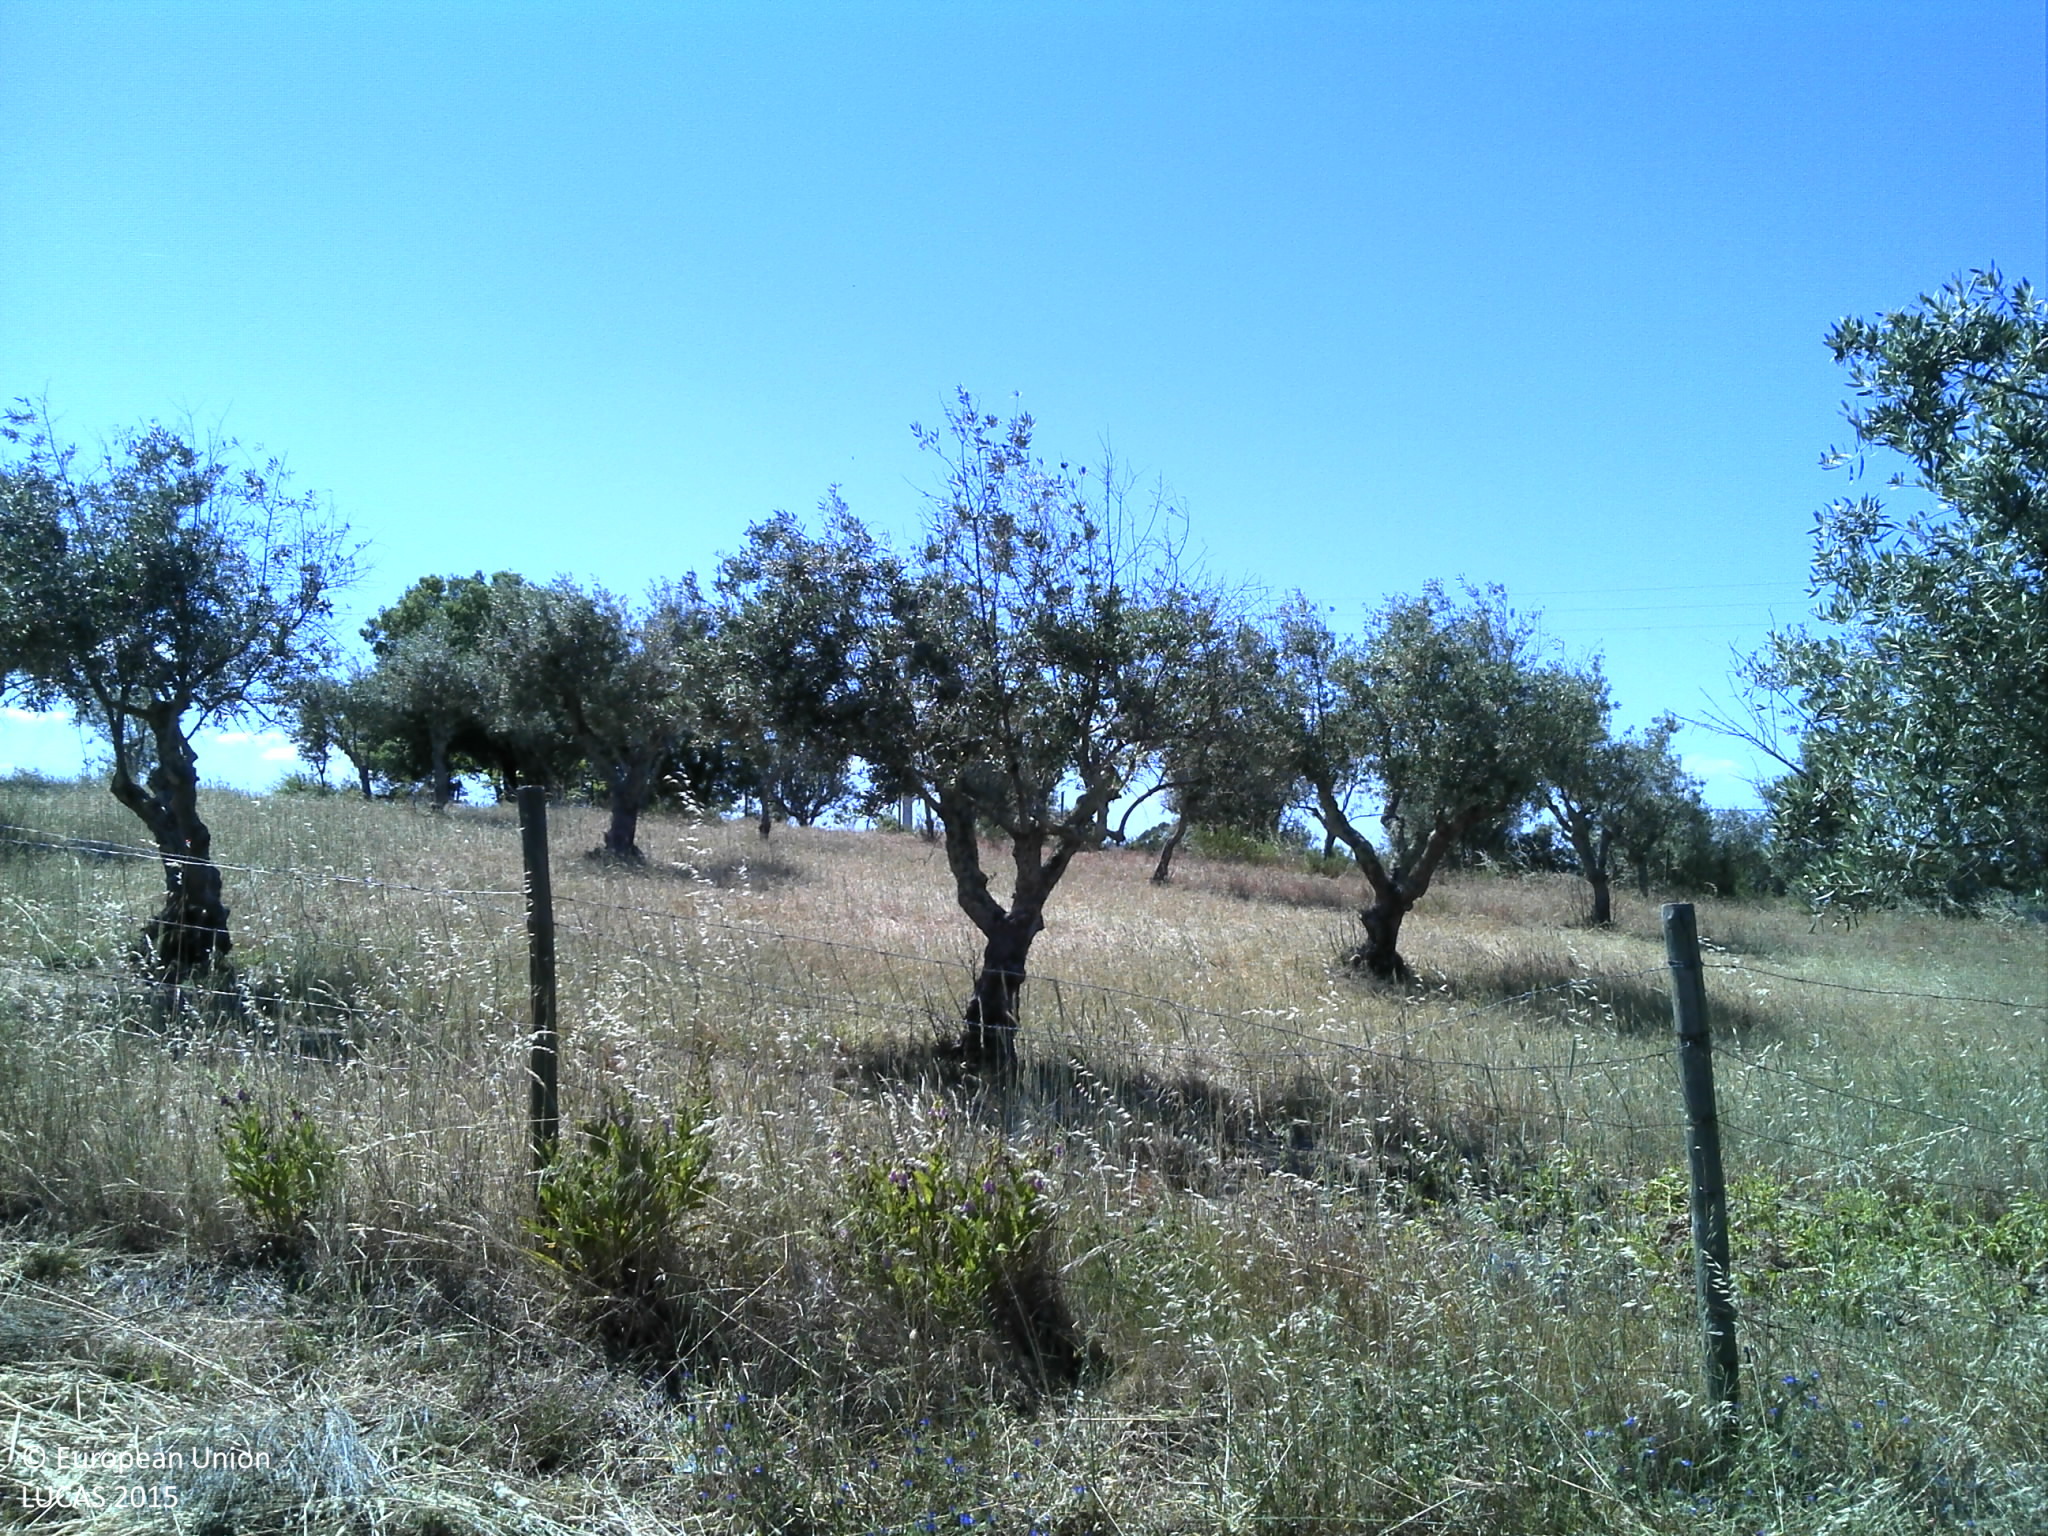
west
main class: Cropland
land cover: Olive groves
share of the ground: 25 - 50 %
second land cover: Grassland without tree/shrub cover
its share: 25 - 50 %
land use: Agriculture (excluding fallow land and kitchen gardens)
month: May
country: PT
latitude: 39.4161
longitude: -7.7170
